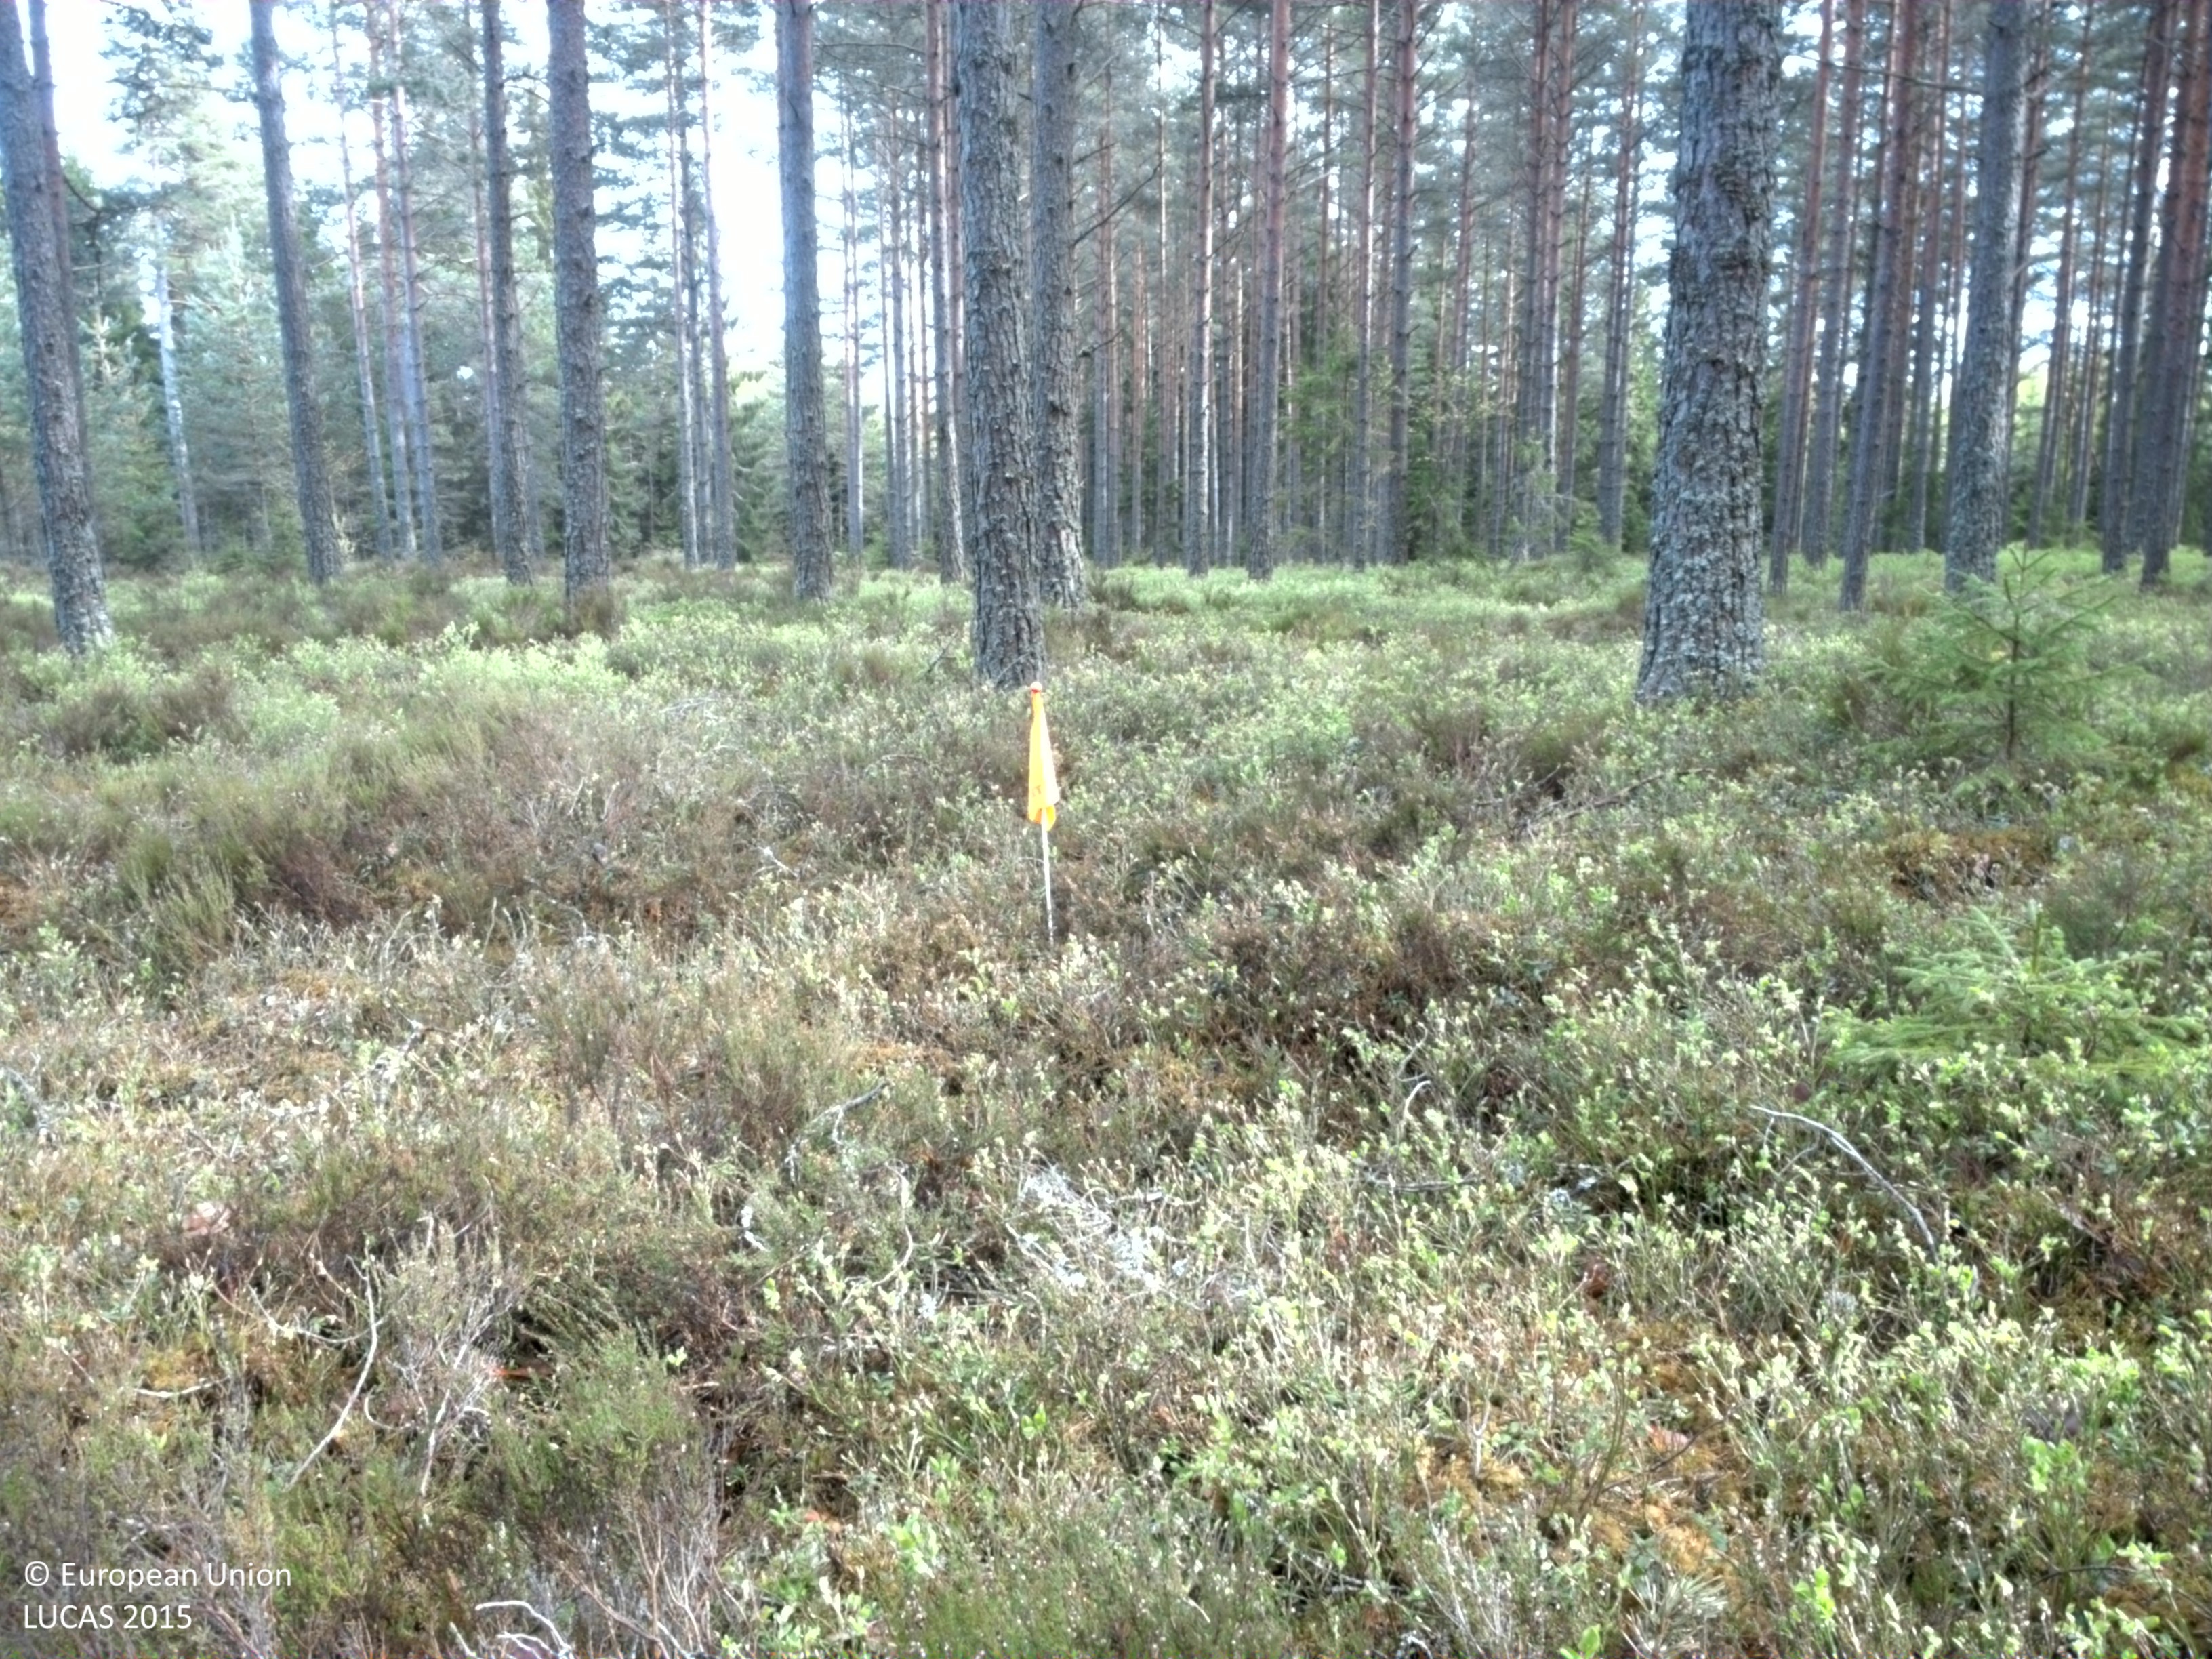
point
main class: Woodland
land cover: Pine dominated coniferous woodland
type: boreal forest
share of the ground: 50 - 75 %
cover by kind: coniferous forest trees 50 %, shrubs 40 %, herbaceous plants 5 %, lichens and mosses 5 %
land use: Forestry
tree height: > 5 m
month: May
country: SE
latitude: 59.1583
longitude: 14.3464
